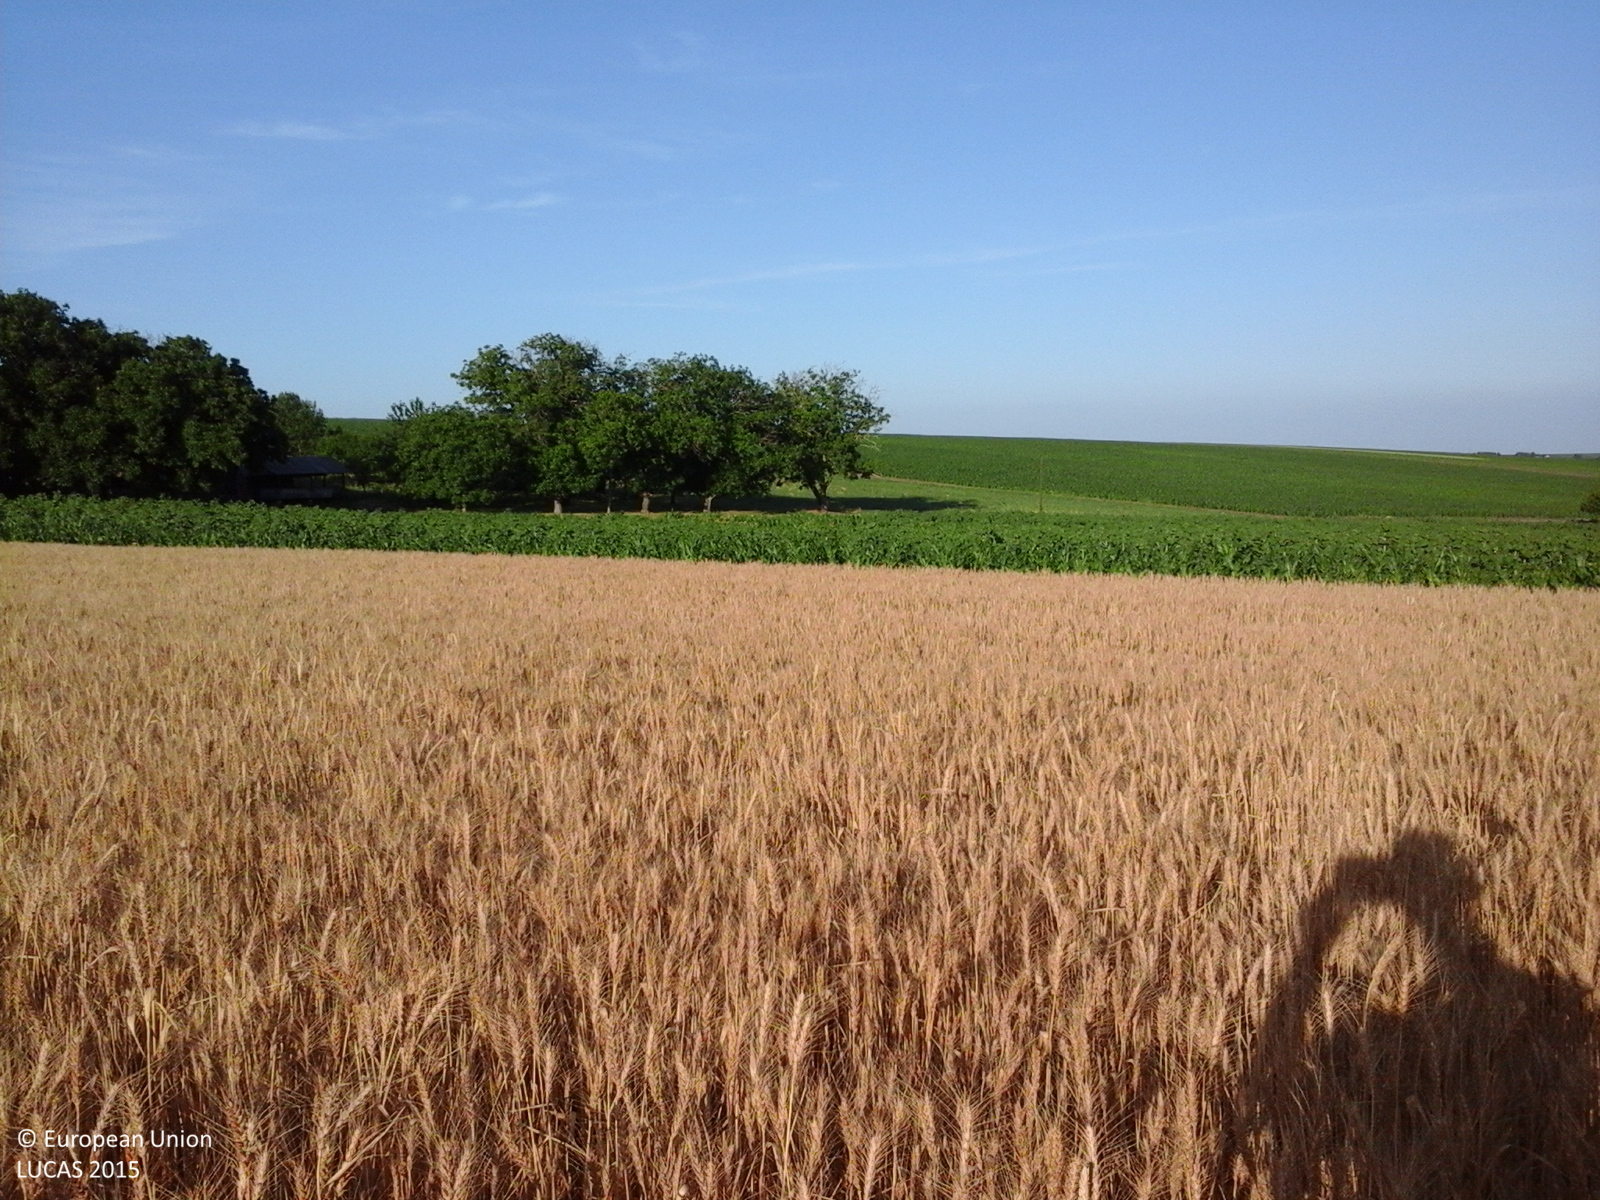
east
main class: Cropland
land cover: Common wheat
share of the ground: > 75 %
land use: Agriculture (excluding fallow land and kitchen gardens)
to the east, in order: Common wheat; Maize; Sunflower; Maize; Grass margins; Tracks; Grassland without tree/shrub cover; Lines of trees; Grassland without tree/shrub cover; Lucerne
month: June
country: RO
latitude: 47.4104
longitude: 27.0817
